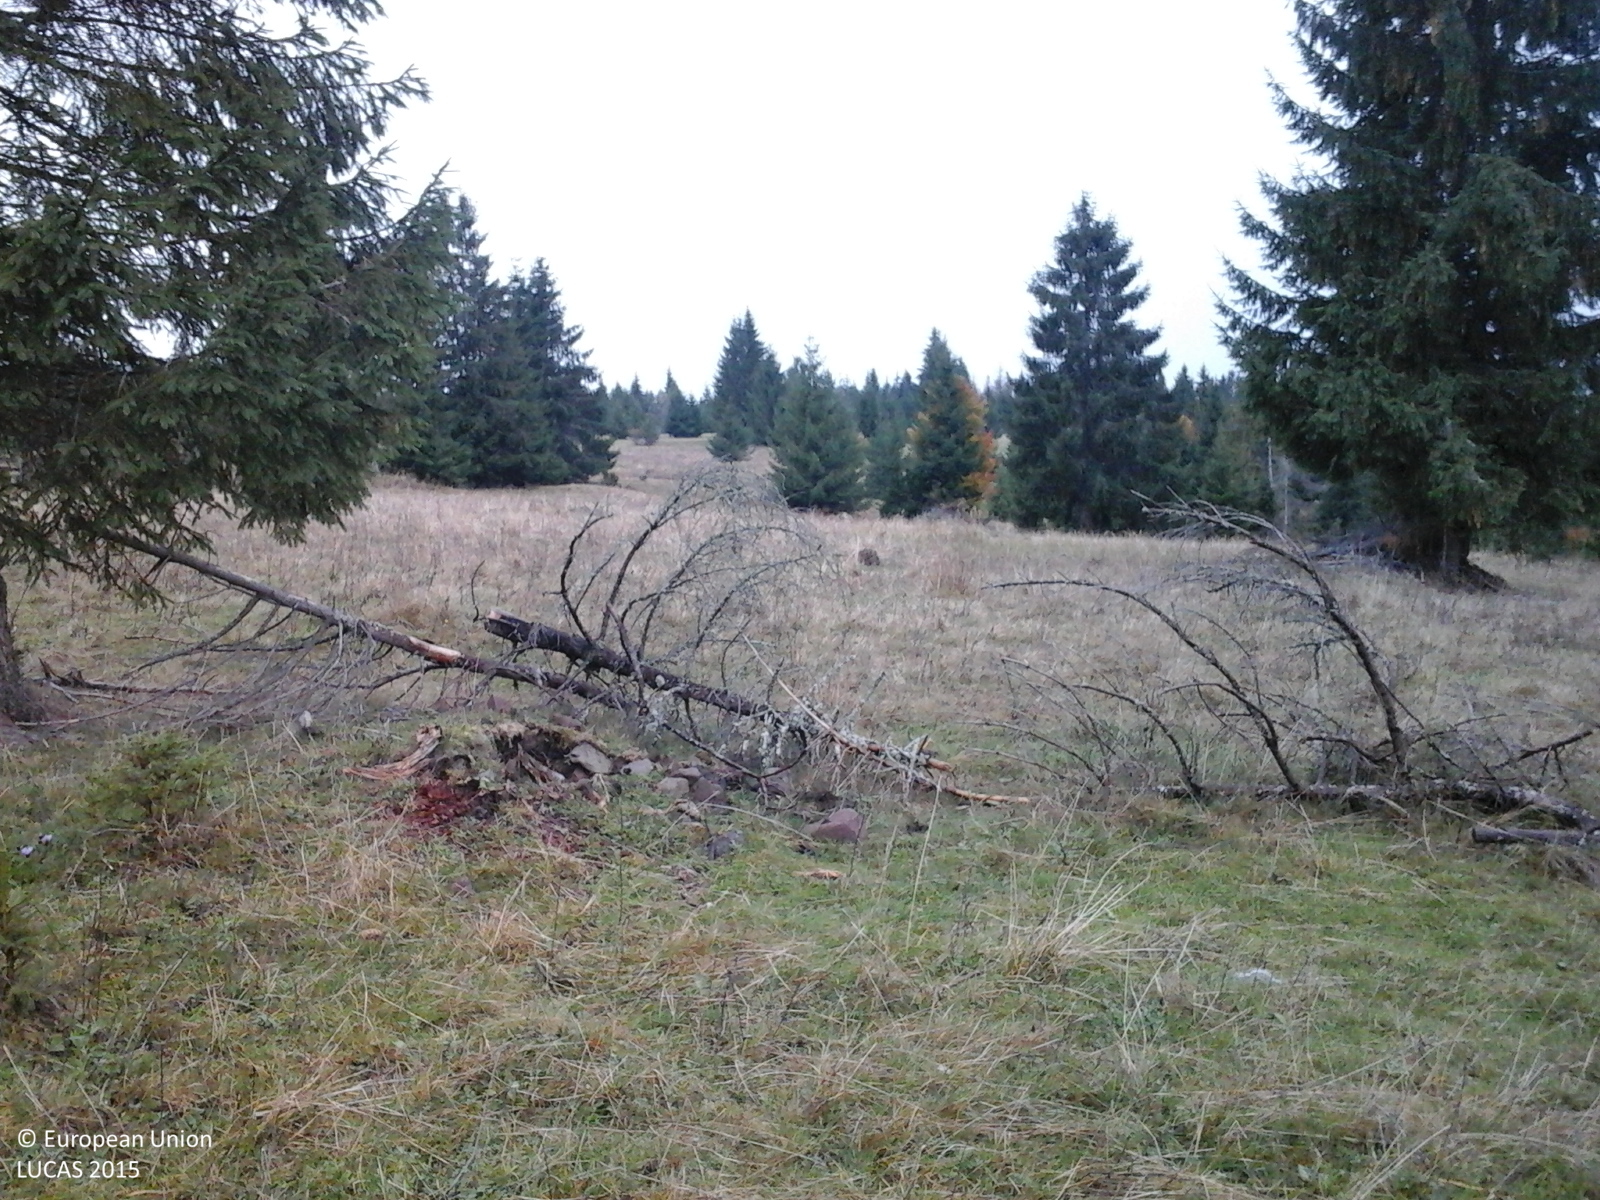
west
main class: Grassland
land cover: Grassland with sparse tree/shrub cover
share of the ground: > 75 %
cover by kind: herbaceous plants 95 %, coniferous forest trees 5 %
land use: Agriculture (excluding fallow land and kitchen gardens)
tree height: > 5 m
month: October
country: RO
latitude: 46.9345
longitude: 25.2510
